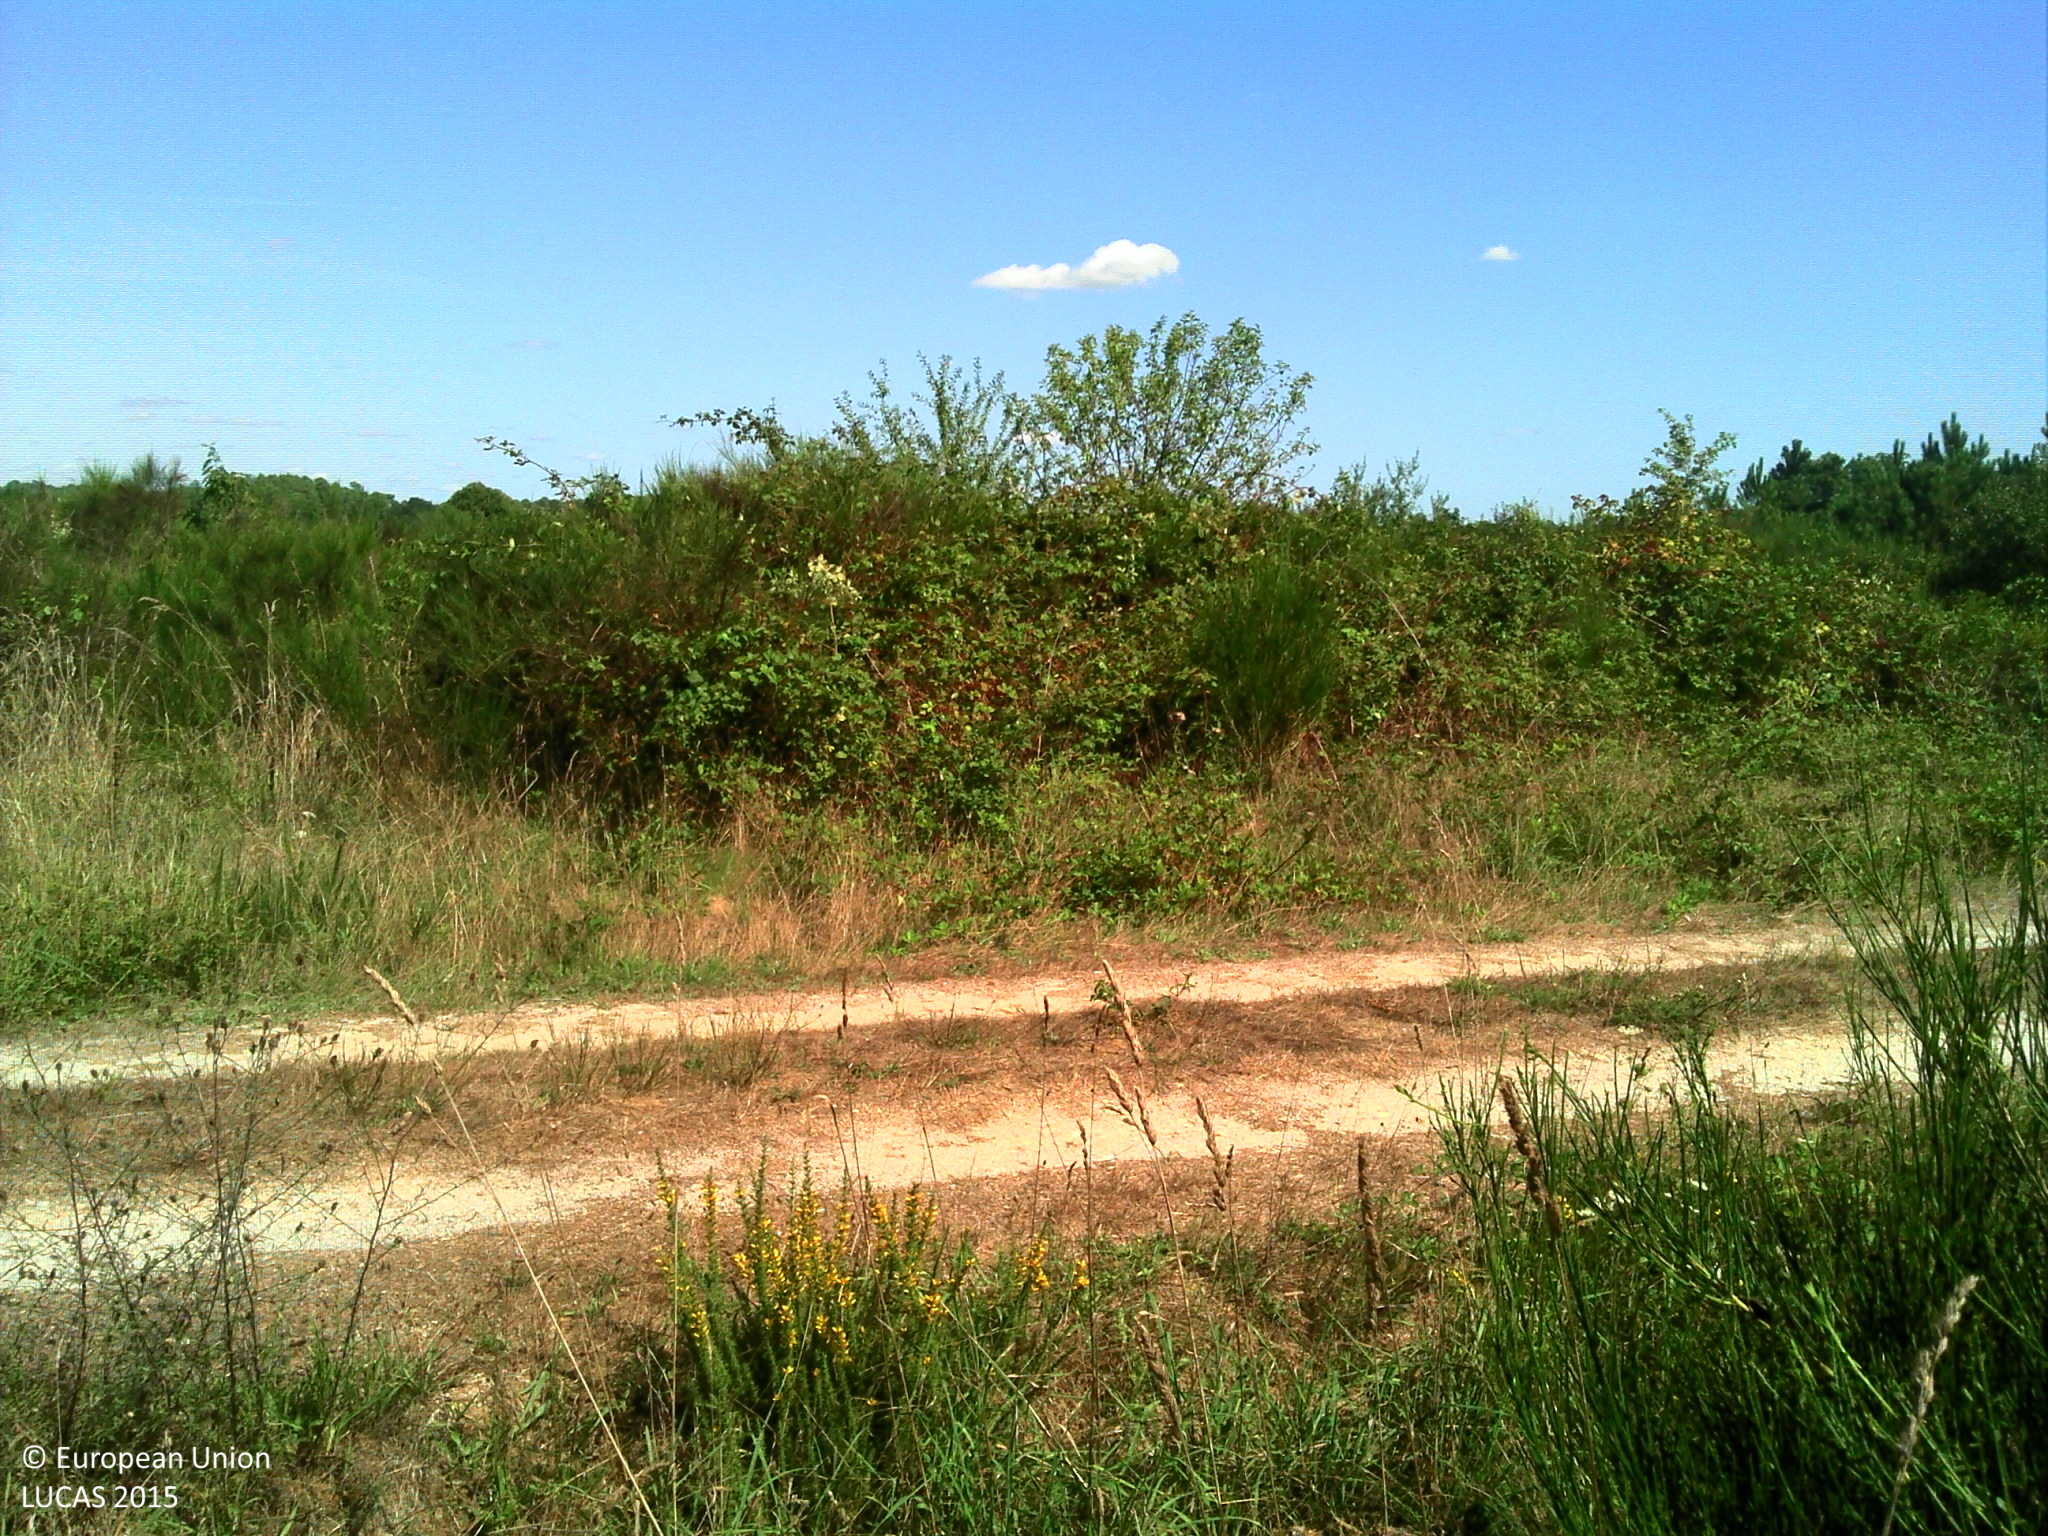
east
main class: Woodland
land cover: Pine dominated coniferous woodland
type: exotic forest
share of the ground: > 75 %
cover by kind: coniferous forest trees 70 %, shrubs 20 %, herbaceous plants 10 %
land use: Forestry
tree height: < 5 m
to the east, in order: Pine dominated coniferous woodland; Grass margins; Tracks; Grass margins; Pine dominated coniferous woodland; Fences; Tracks; Grassland with sparse tree/shrub cover; Inland fresh water bodies; Broadleaved woodland
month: August
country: FR
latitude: 44.9813
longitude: 0.4654
